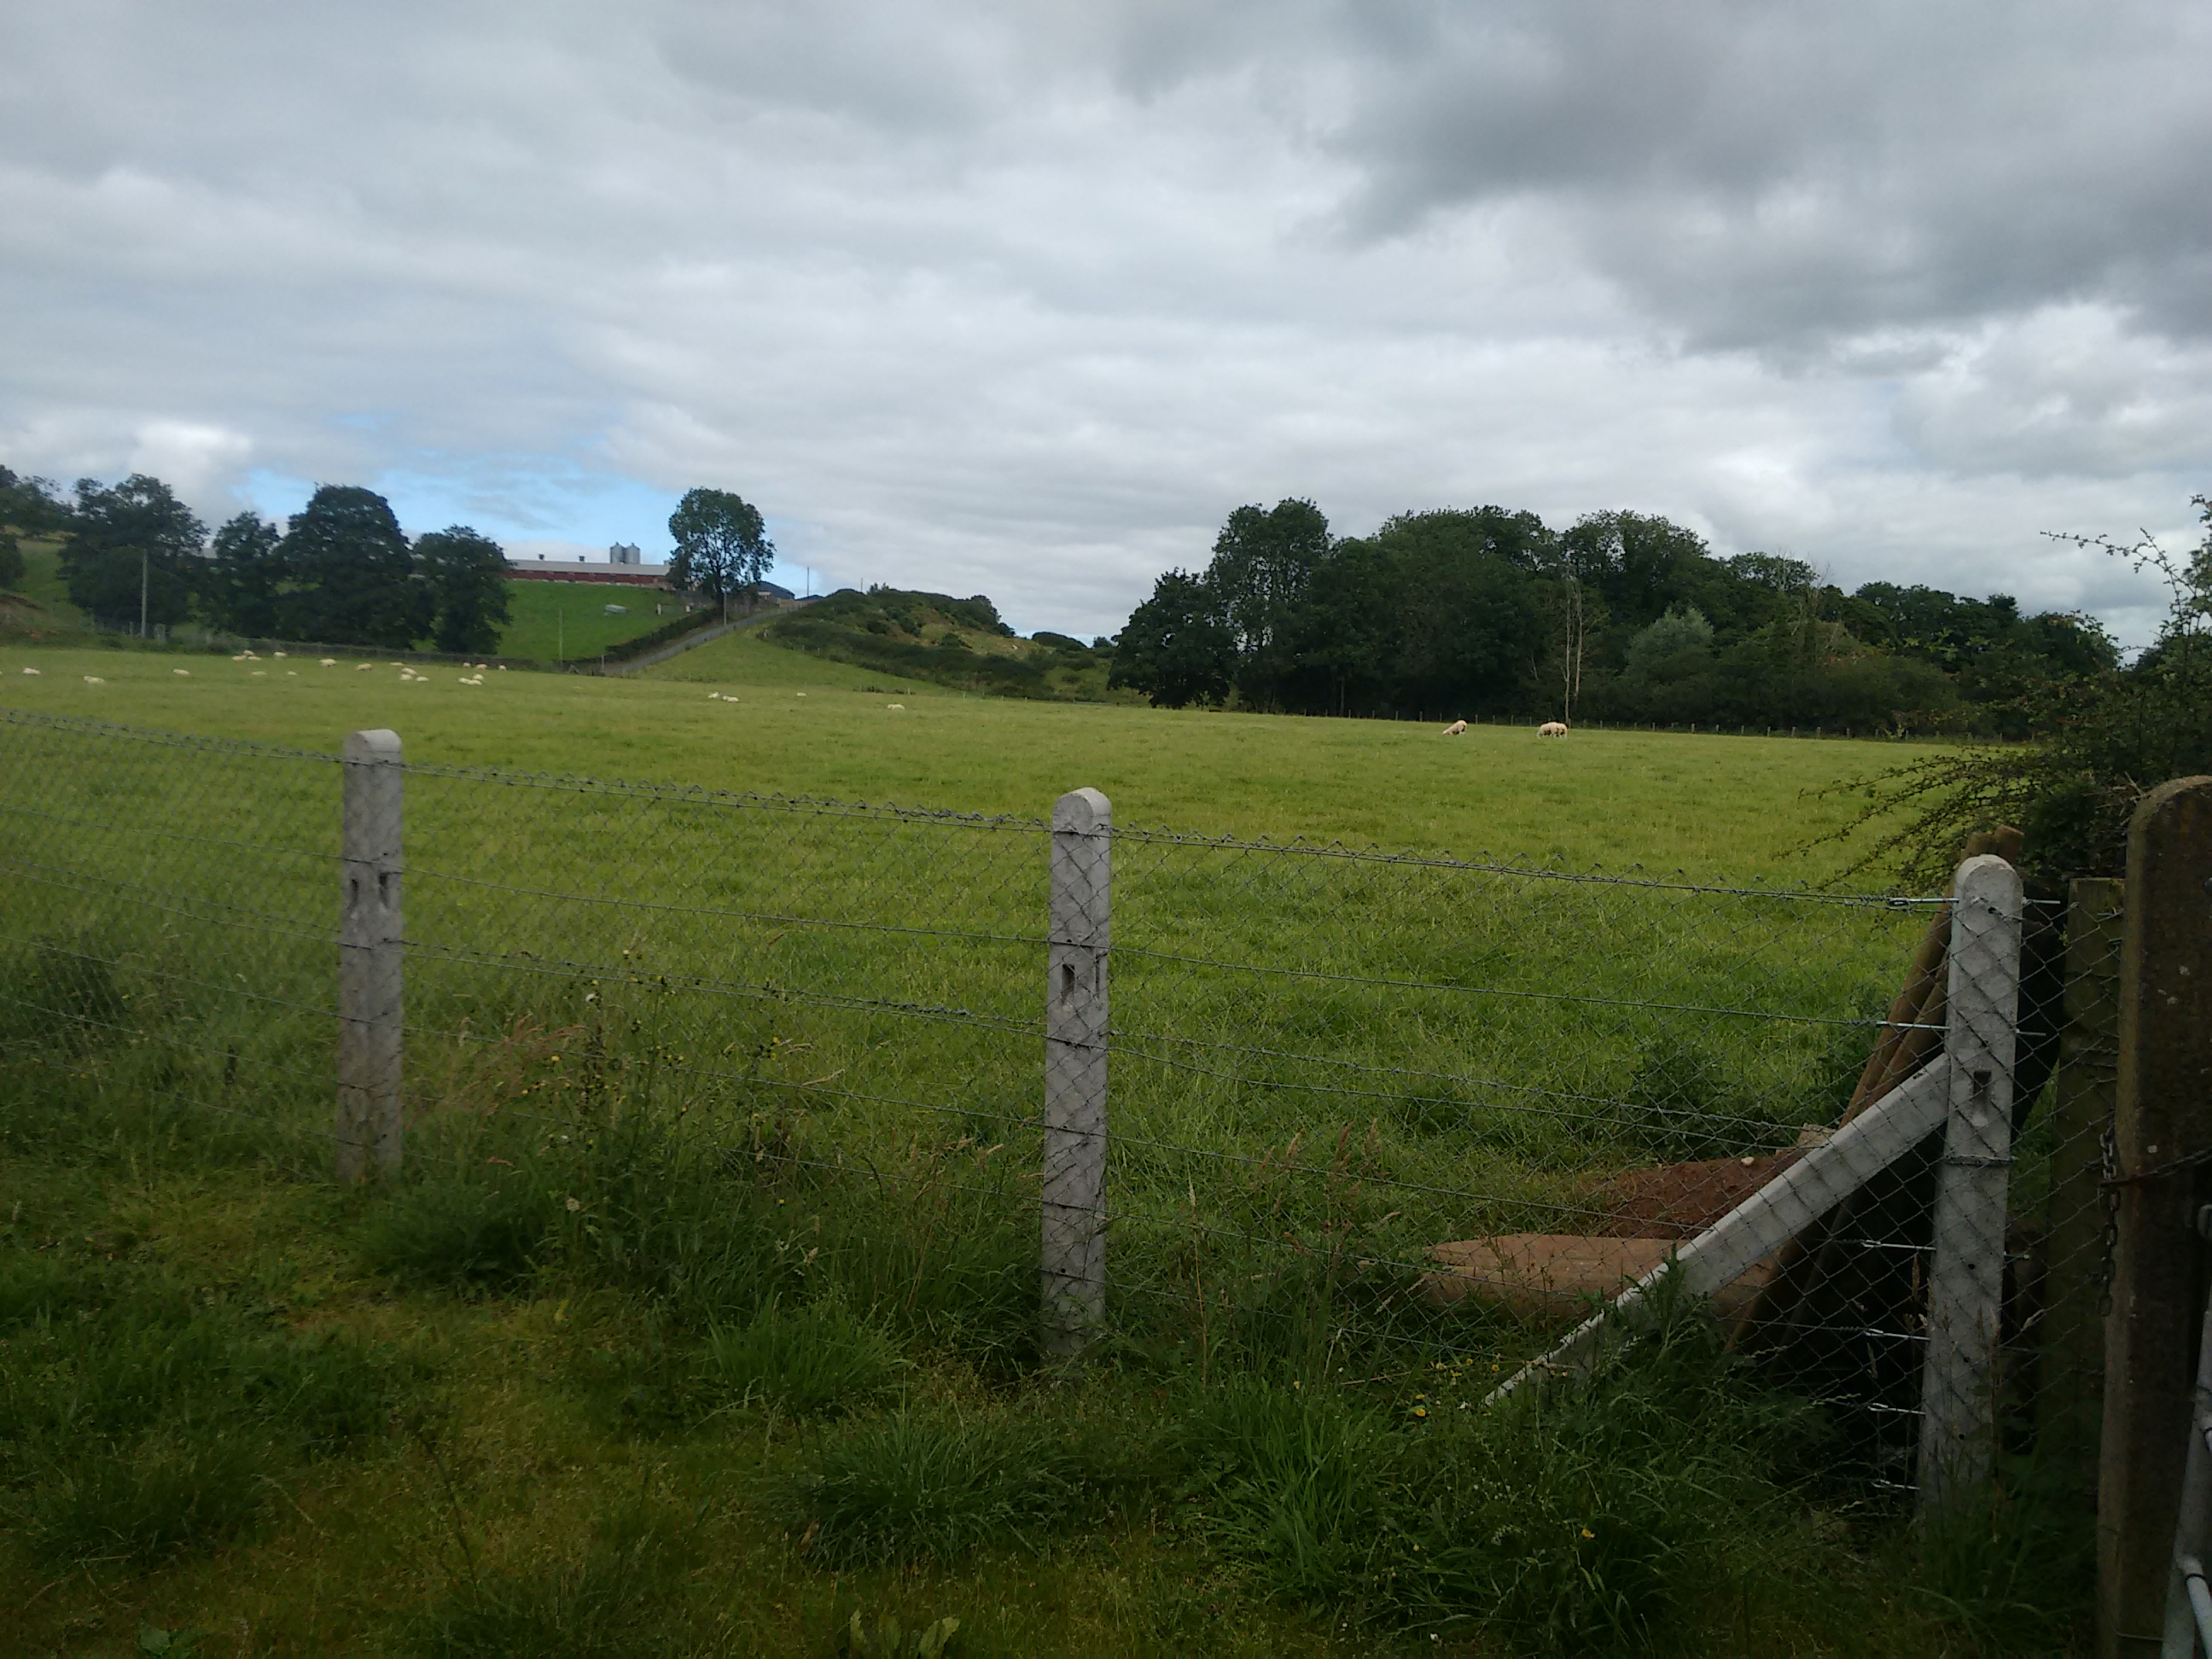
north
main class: Grassland
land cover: Grassland without tree/shrub cover
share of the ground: > 75 %
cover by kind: herbaceous plants 100 %
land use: Agriculture (excluding fallow land and kitchen gardens)
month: August
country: GB
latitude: 54.4416
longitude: -6.8019
